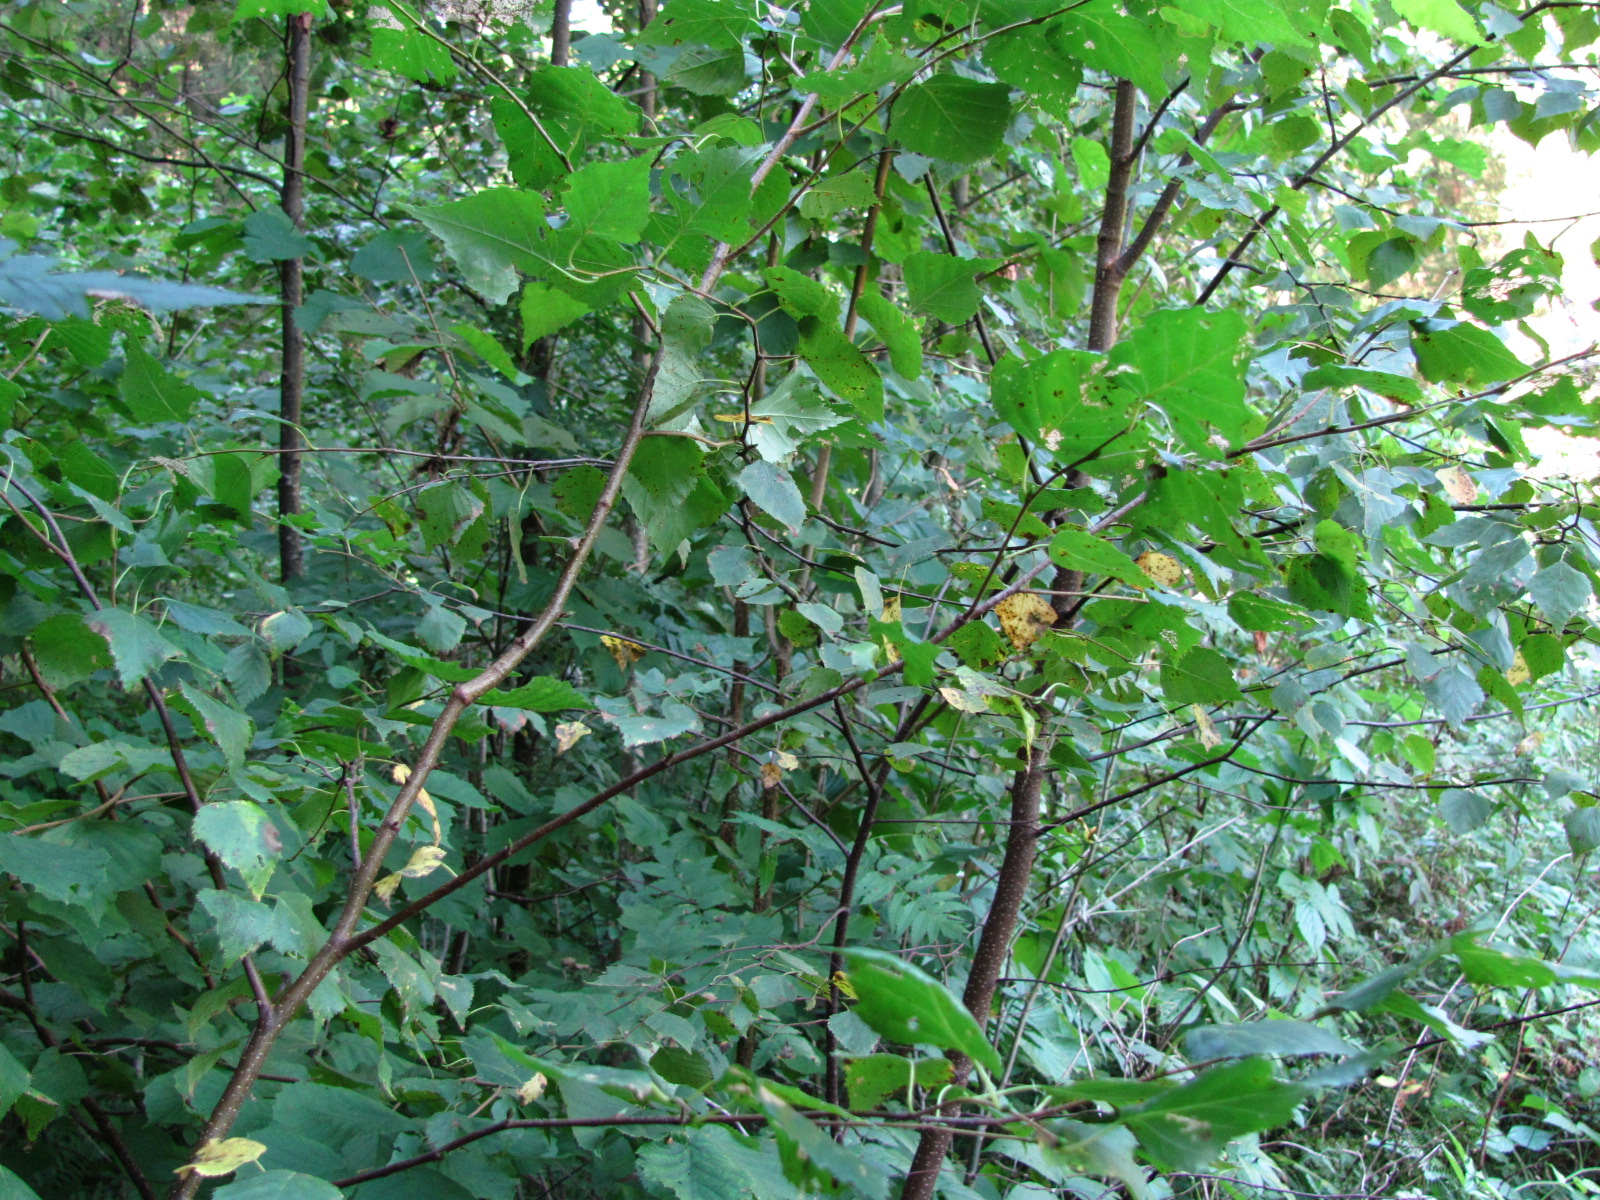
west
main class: Woodland
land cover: Broadleaved woodland
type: non-riverine alder, birch or aspen forest
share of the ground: > 75 %
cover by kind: broadleaved forest trees 85 %, herbaceous plants 15 %
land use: Forestry
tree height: > 5 m
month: August
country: LV
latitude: 56.6688
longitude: 23.9037
